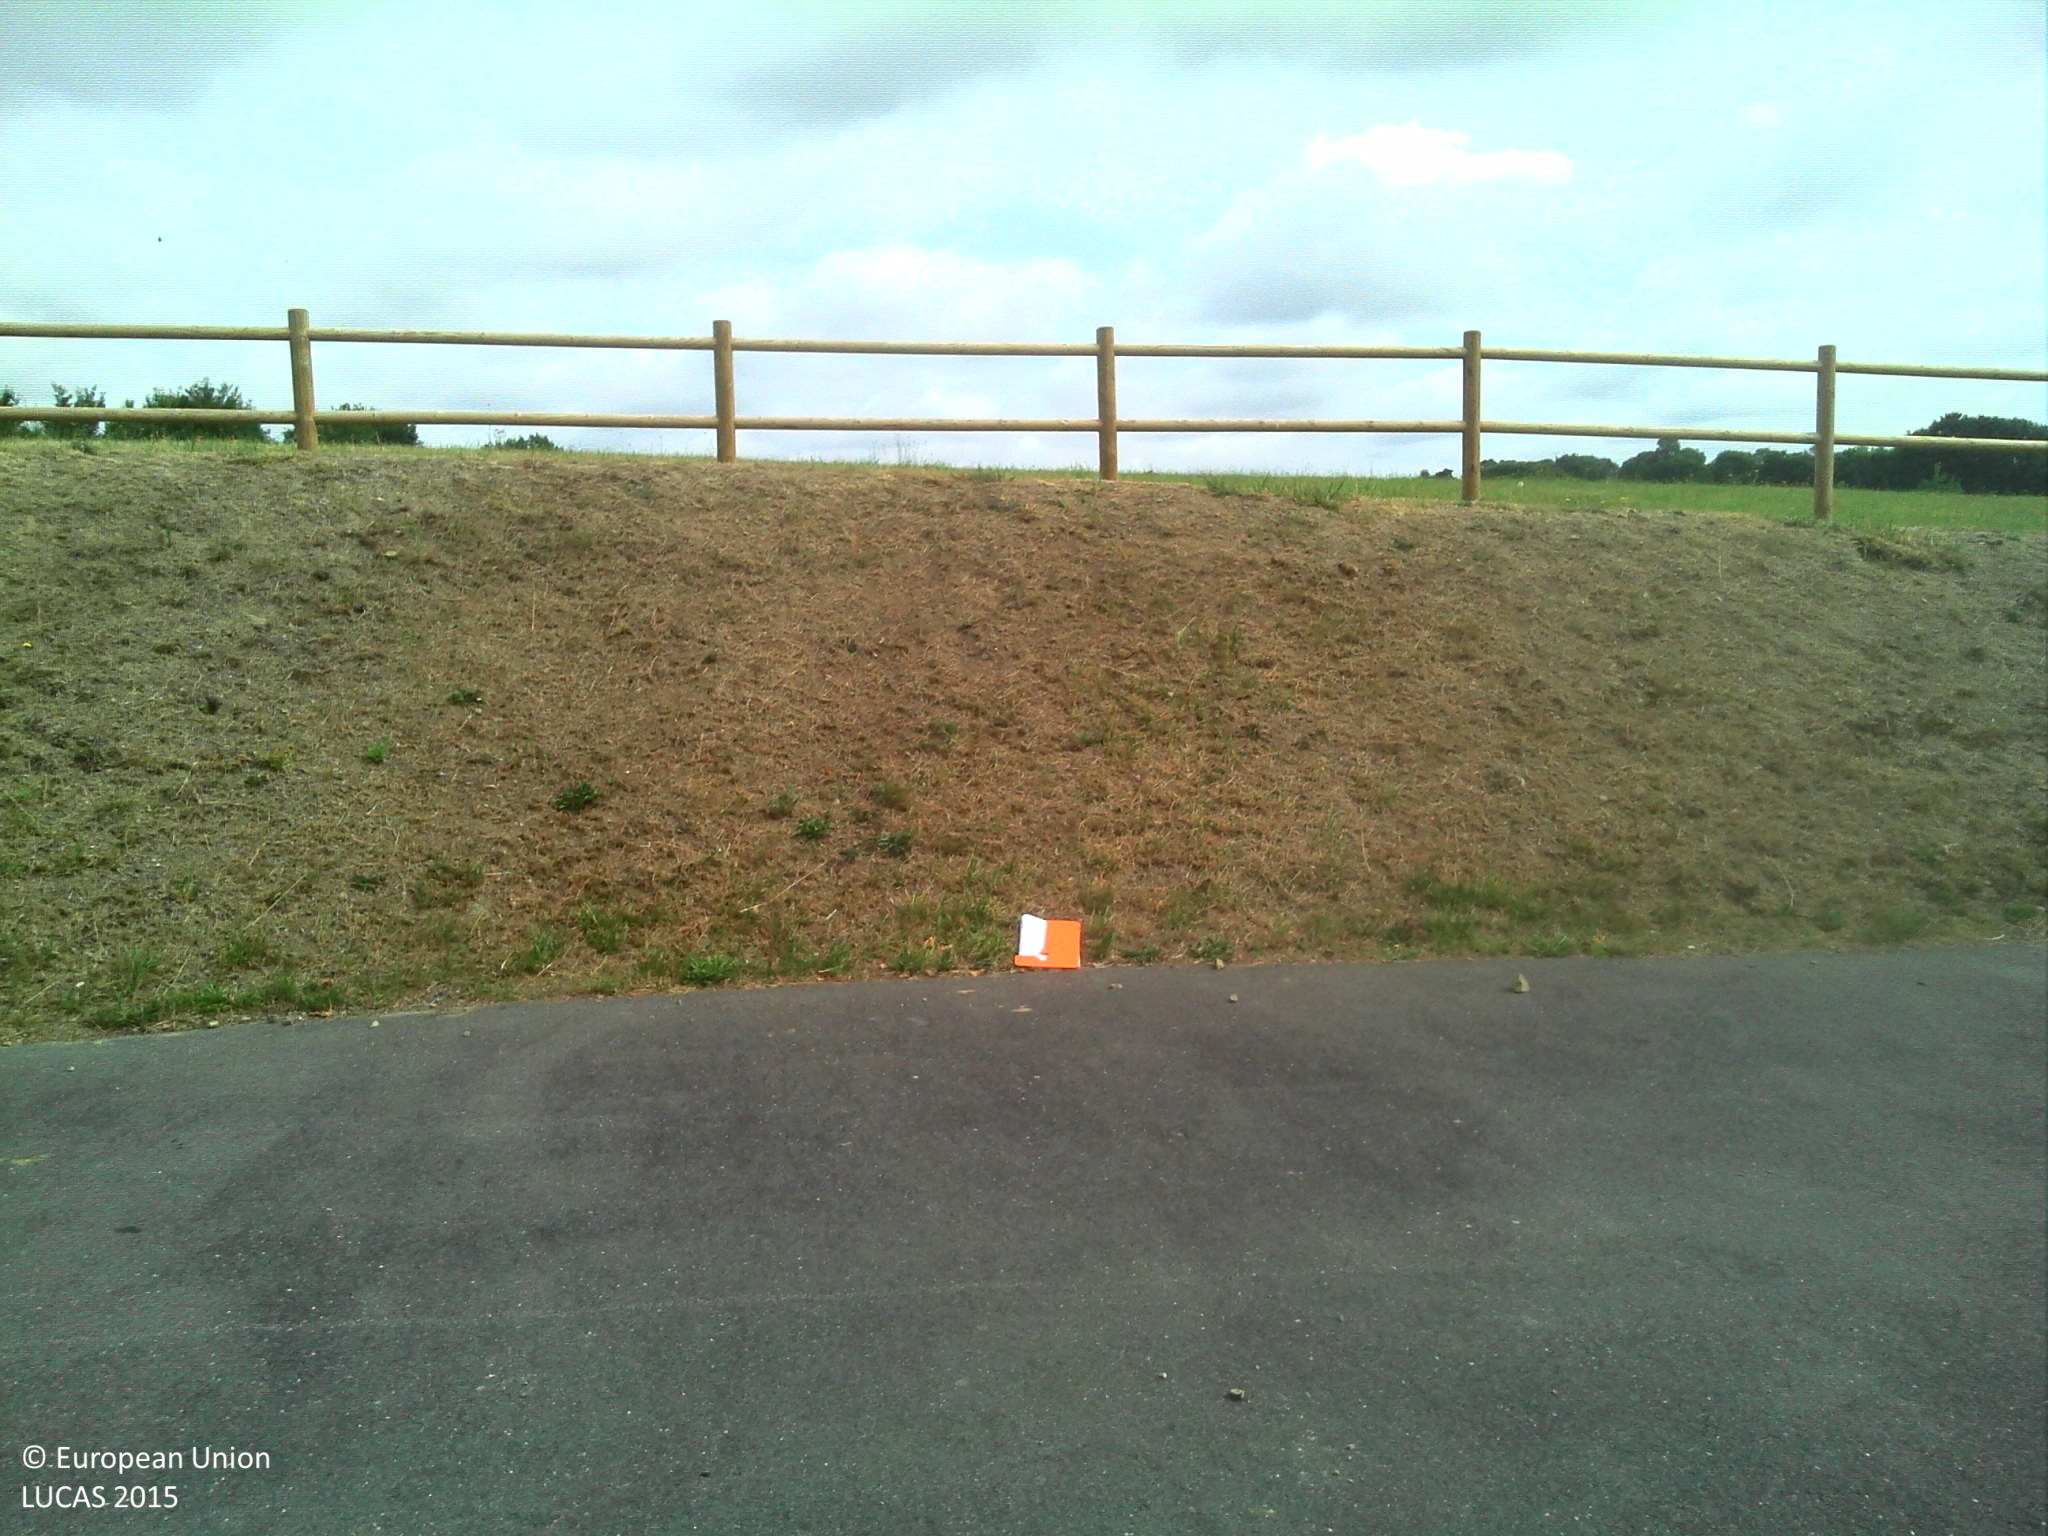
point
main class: Grassland
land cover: Grassland without tree/shrub cover
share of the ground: > 75 %
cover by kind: herbaceous plants 100 %
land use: Semi-natural and natural areas not in use
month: July
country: FR
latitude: 48.7981
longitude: -1.5247
